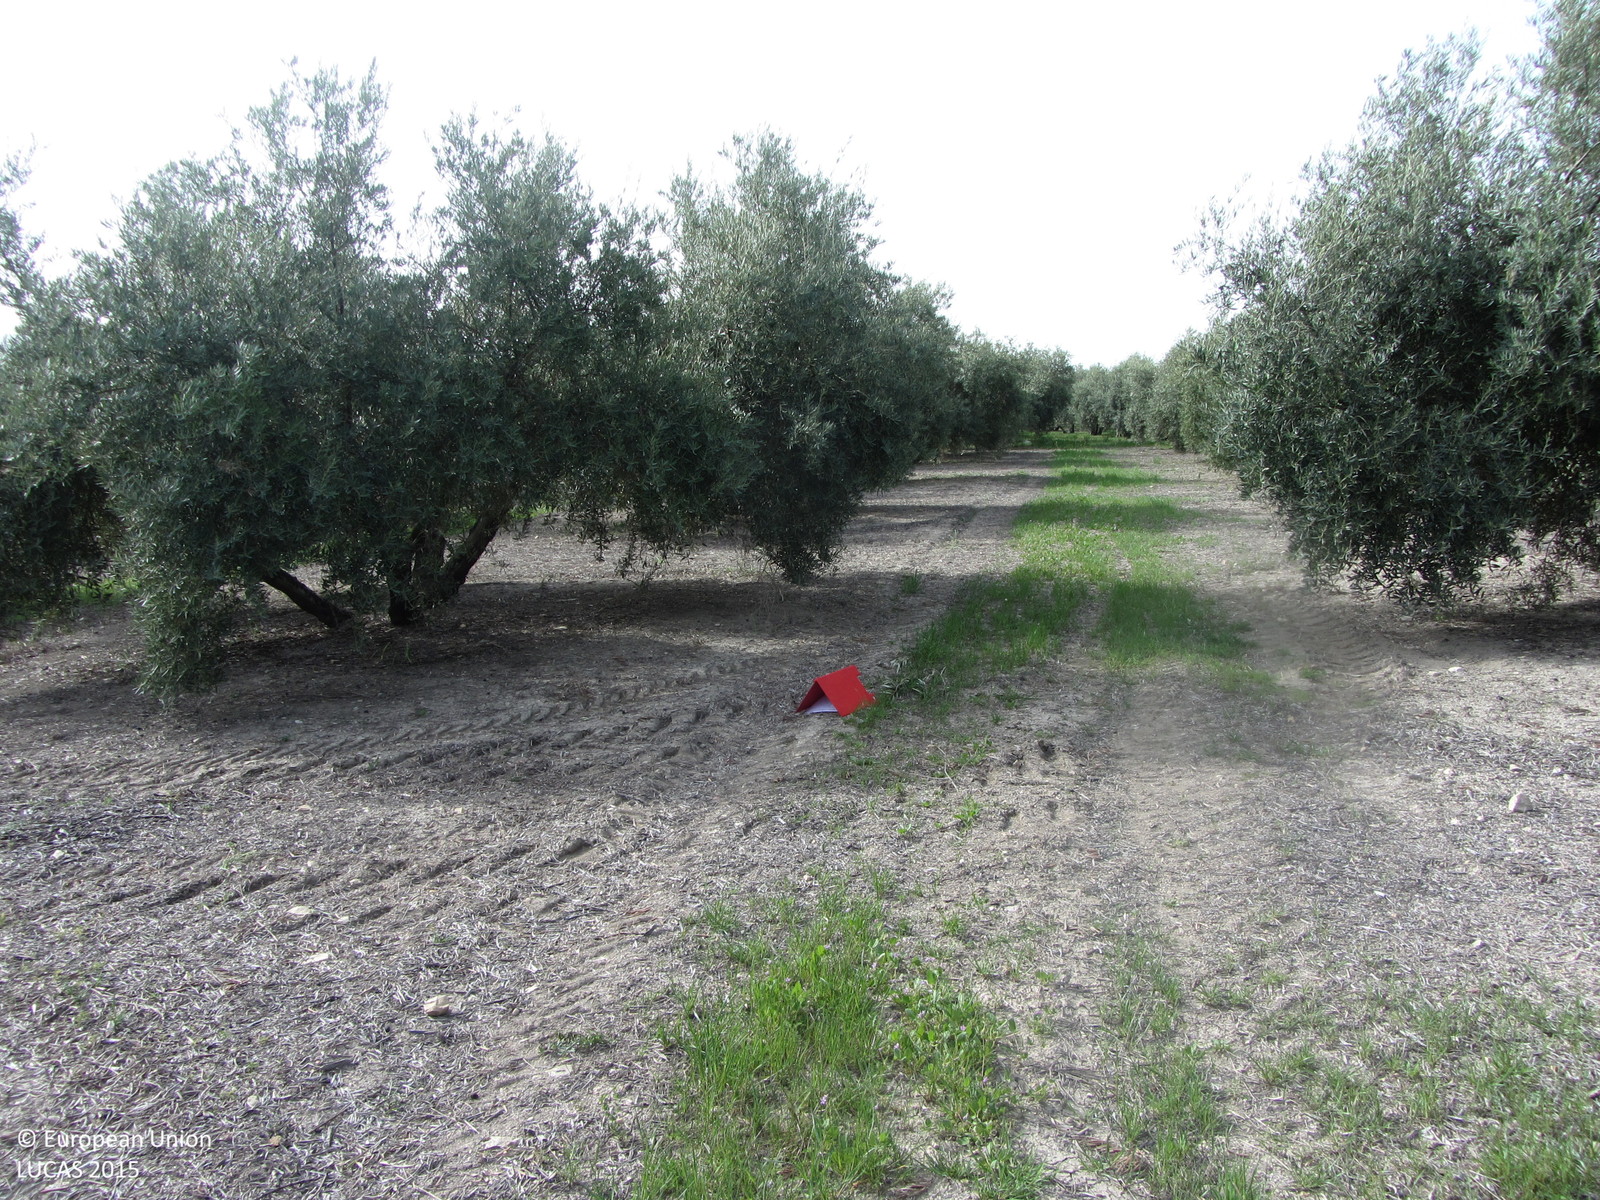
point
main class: Cropland
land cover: Olive groves
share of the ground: 50 - 75 %
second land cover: Spontaneously vegetated surfaces
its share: 10 - 25 %
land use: Agriculture (excluding fallow land and kitchen gardens)
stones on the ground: < 10 %
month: April
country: ES
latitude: 38.1054
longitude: -3.0794
